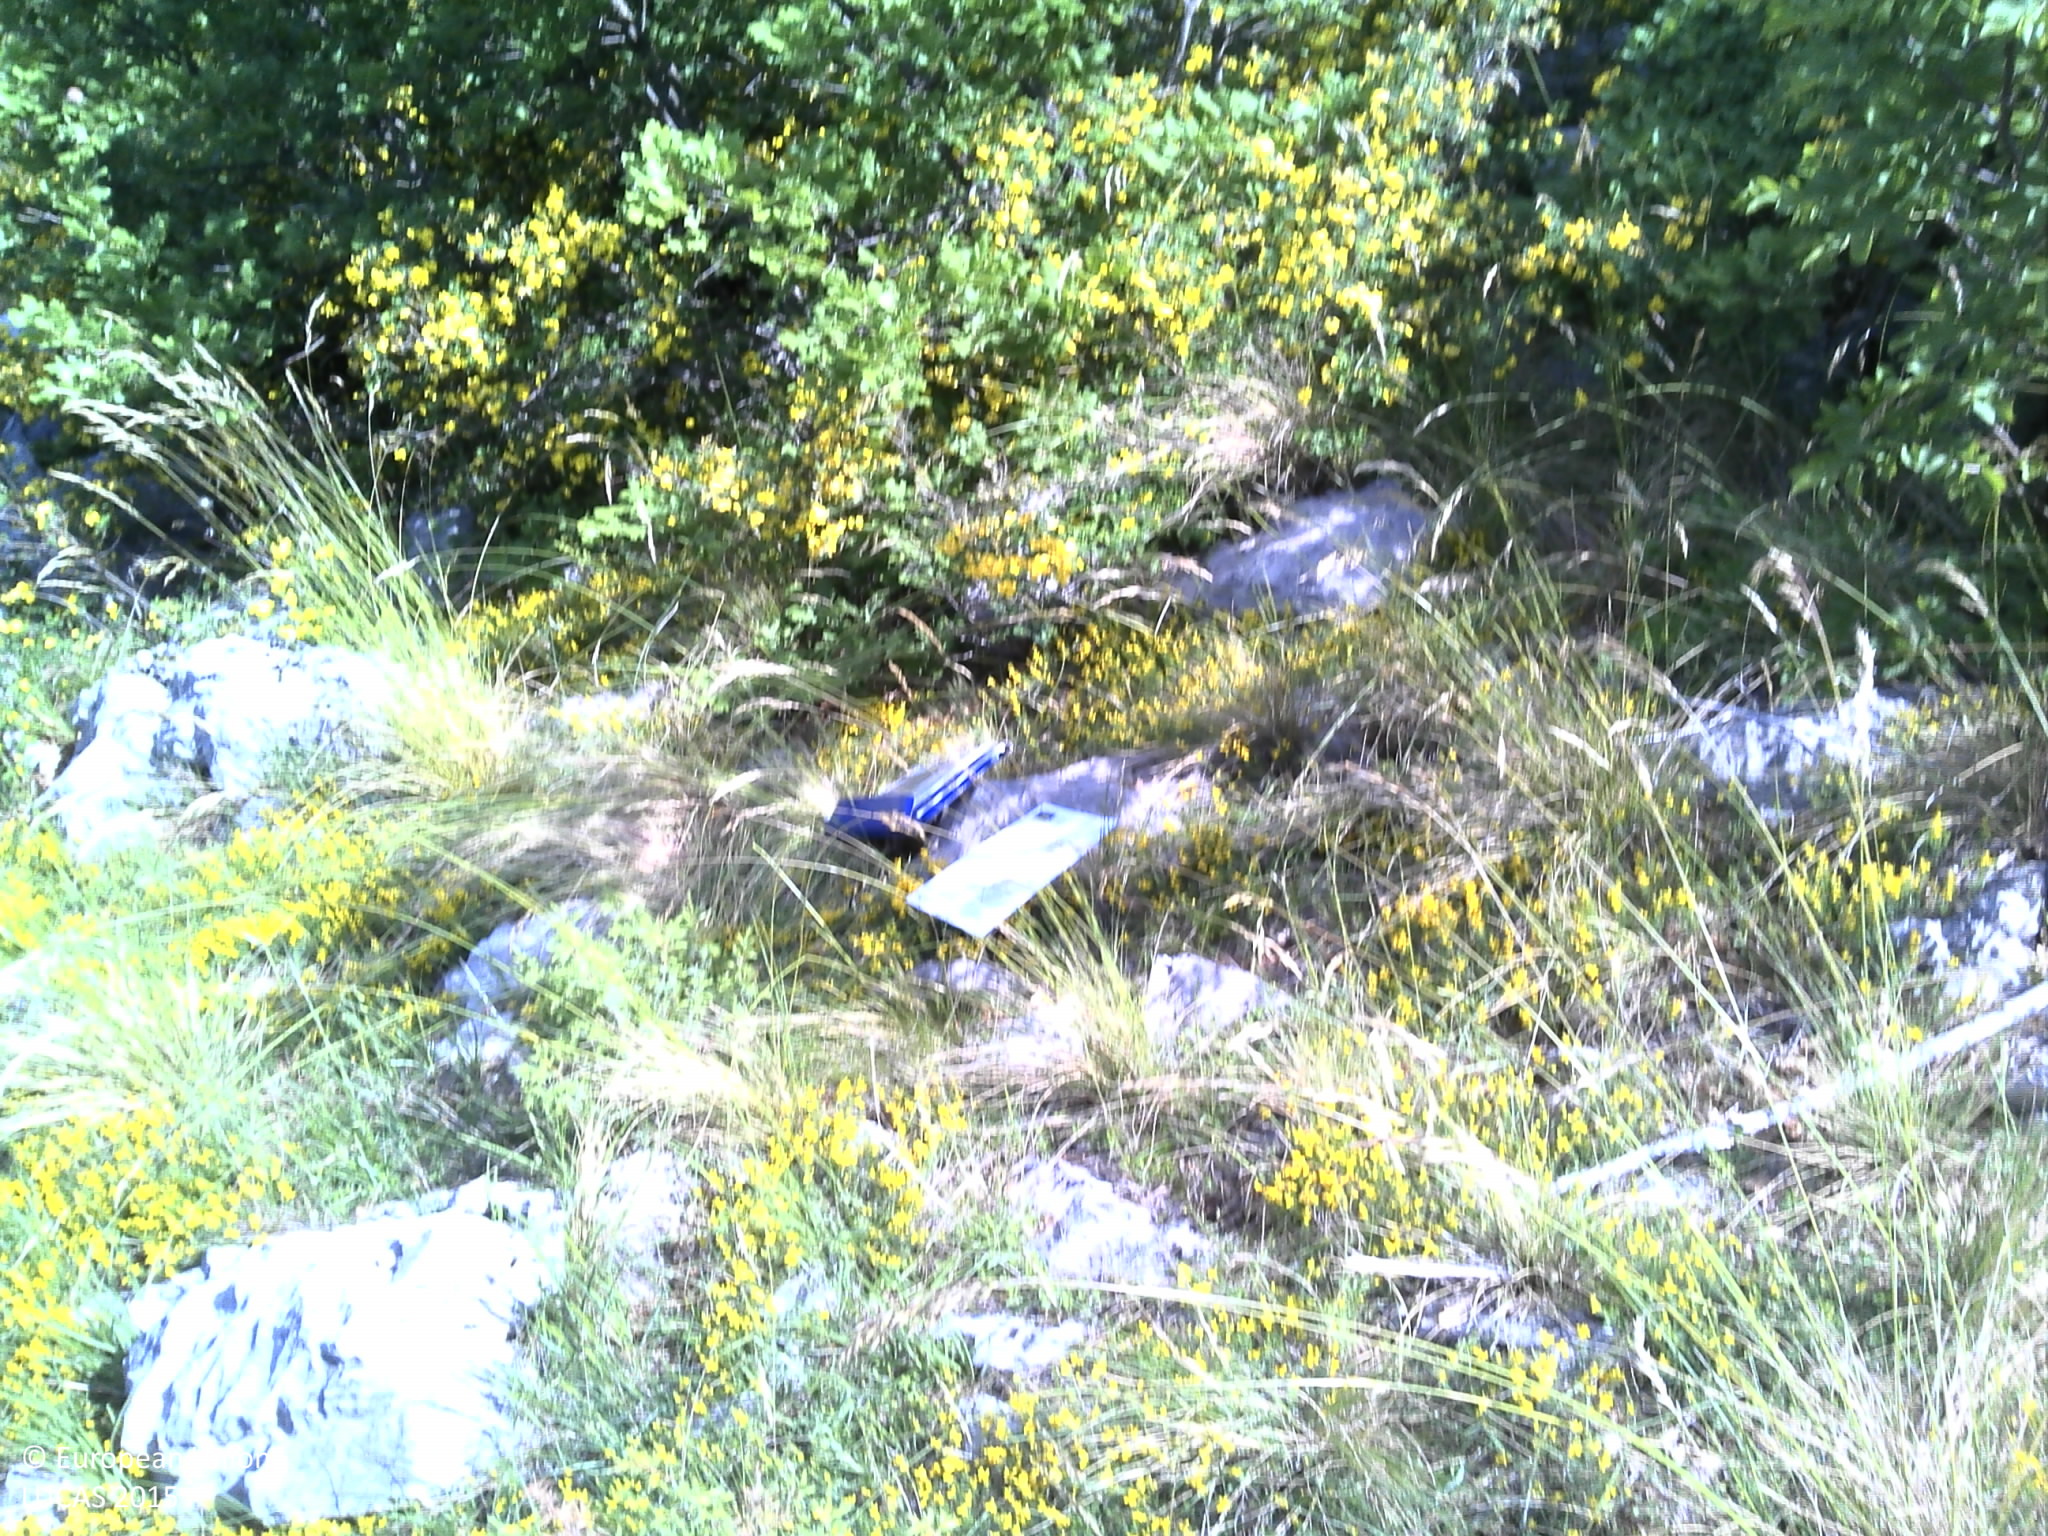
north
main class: Woodland
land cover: Broadleaved woodland
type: thermophilous deciduous forest
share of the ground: 50 - 75 %
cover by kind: shrubs 40 %, broadleaved forest trees 35 %, herbaceous plants 10 %, unconsolidated bare surface 10 %, consolidated bare surface 5 %
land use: Semi-natural and natural areas not in use
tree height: > 5 m
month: May
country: HR
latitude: 44.0538
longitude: 16.2462
